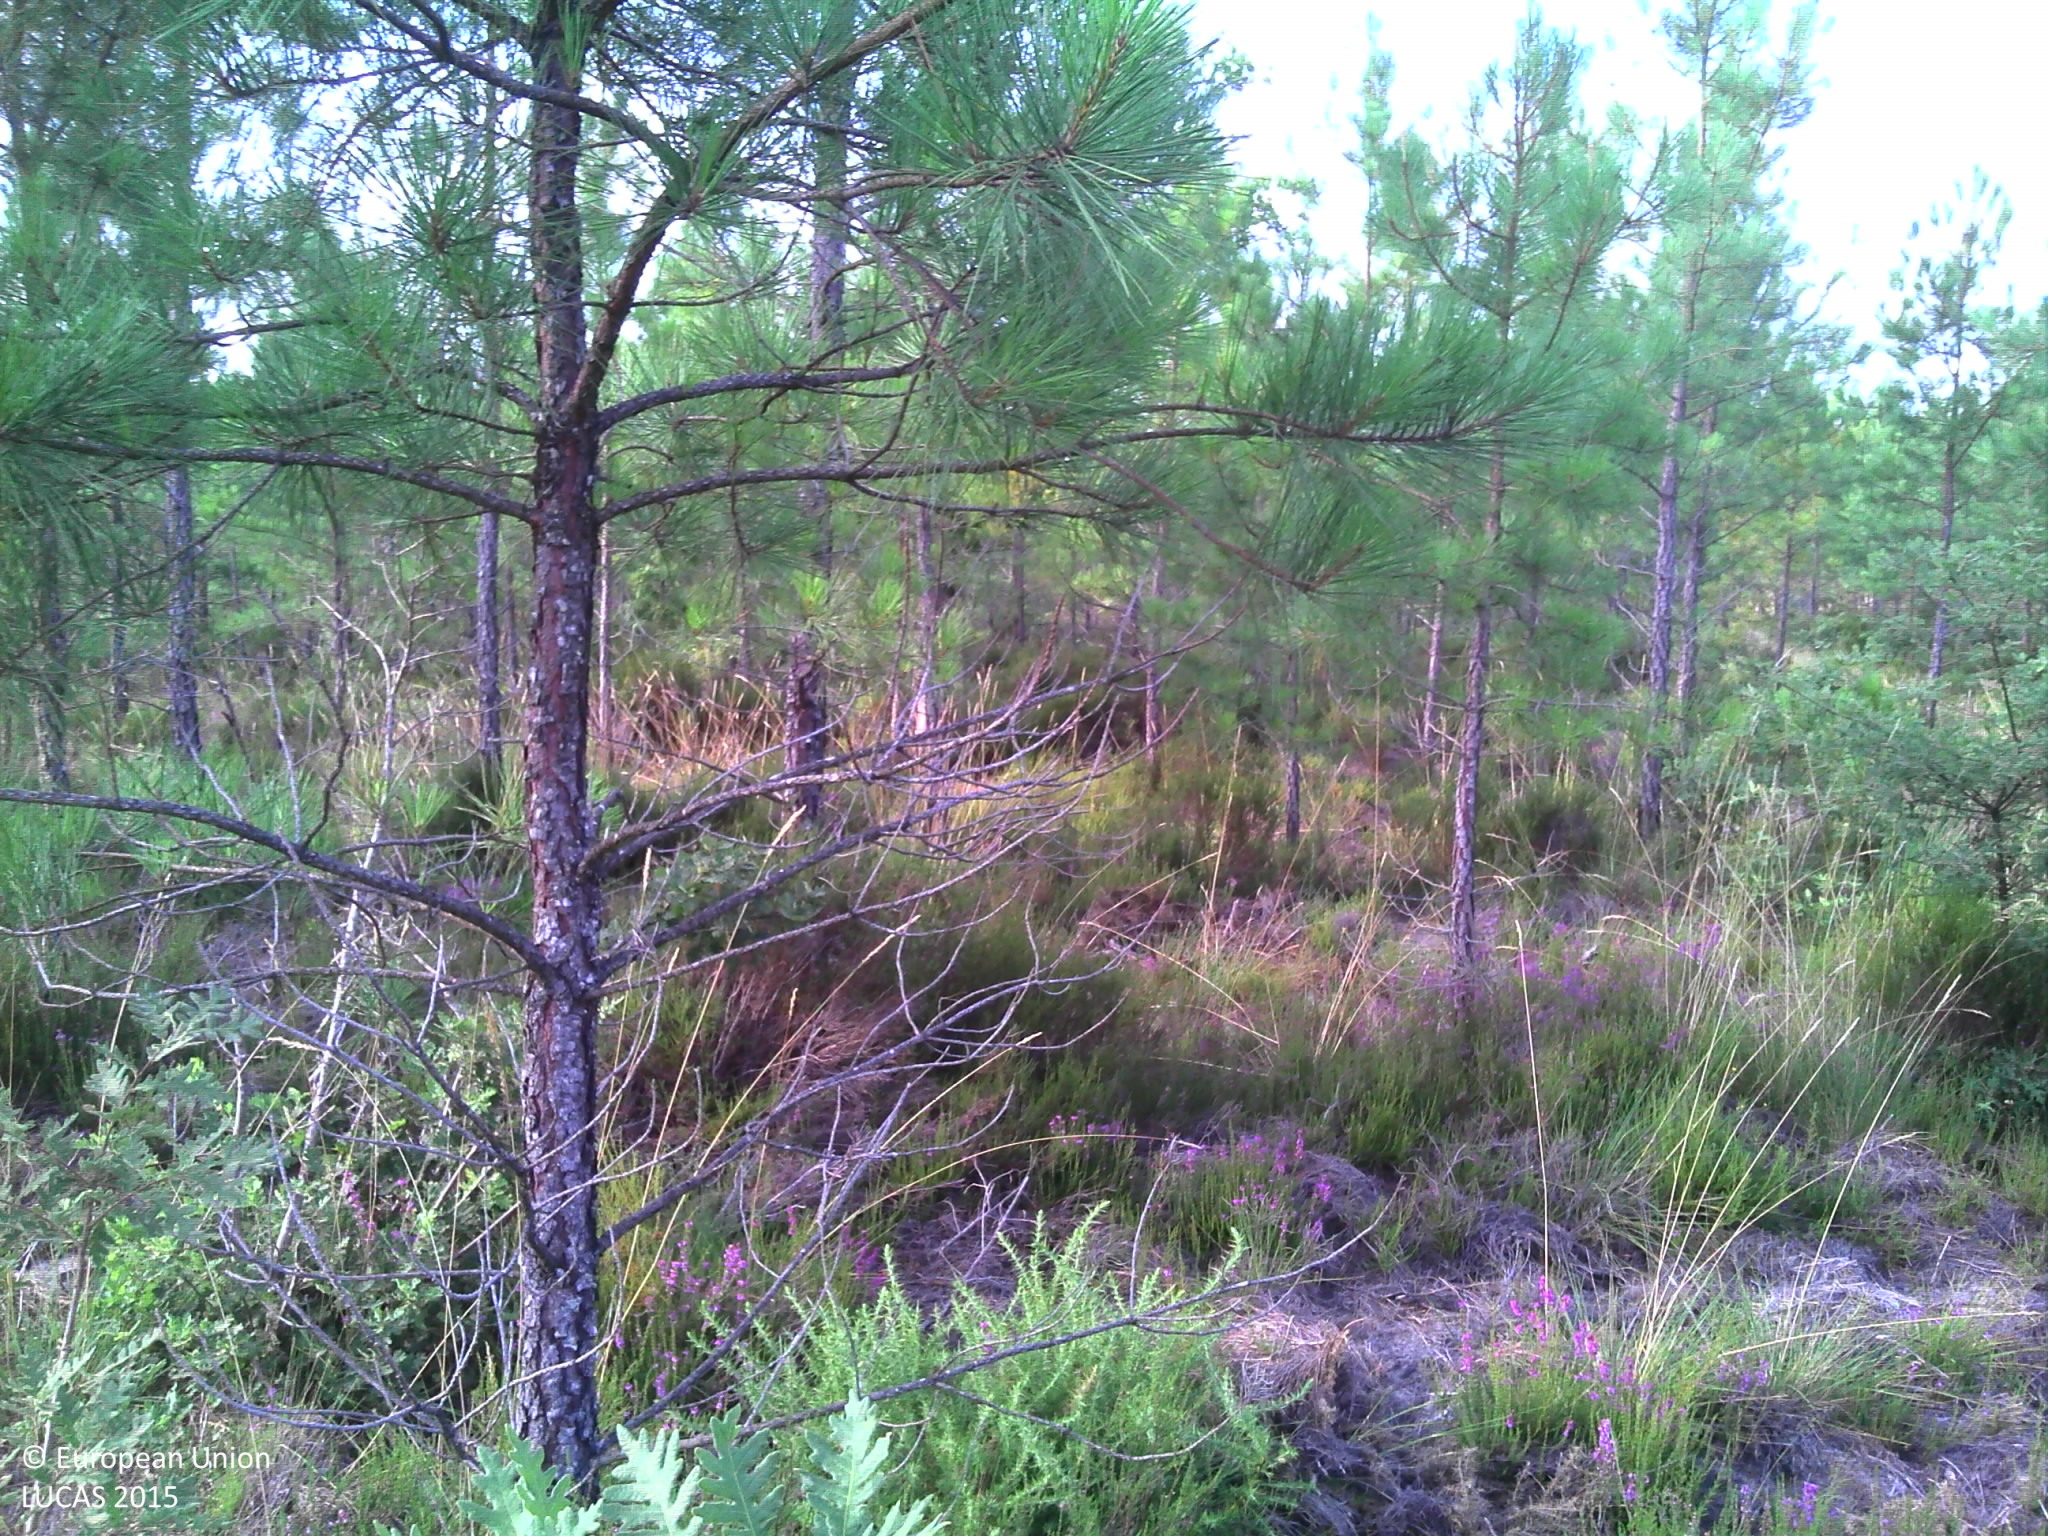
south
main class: Woodland
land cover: Pine dominated coniferous woodland
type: coniferous forest of the mediterranean region
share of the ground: 50 - 75 %
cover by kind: coniferous forest trees 70 %, herbaceous plants 20 %, broadleaved forest trees 10 %
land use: Forestry
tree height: < 5 m
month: July
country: FR
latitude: 44.0644
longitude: -0.5629
